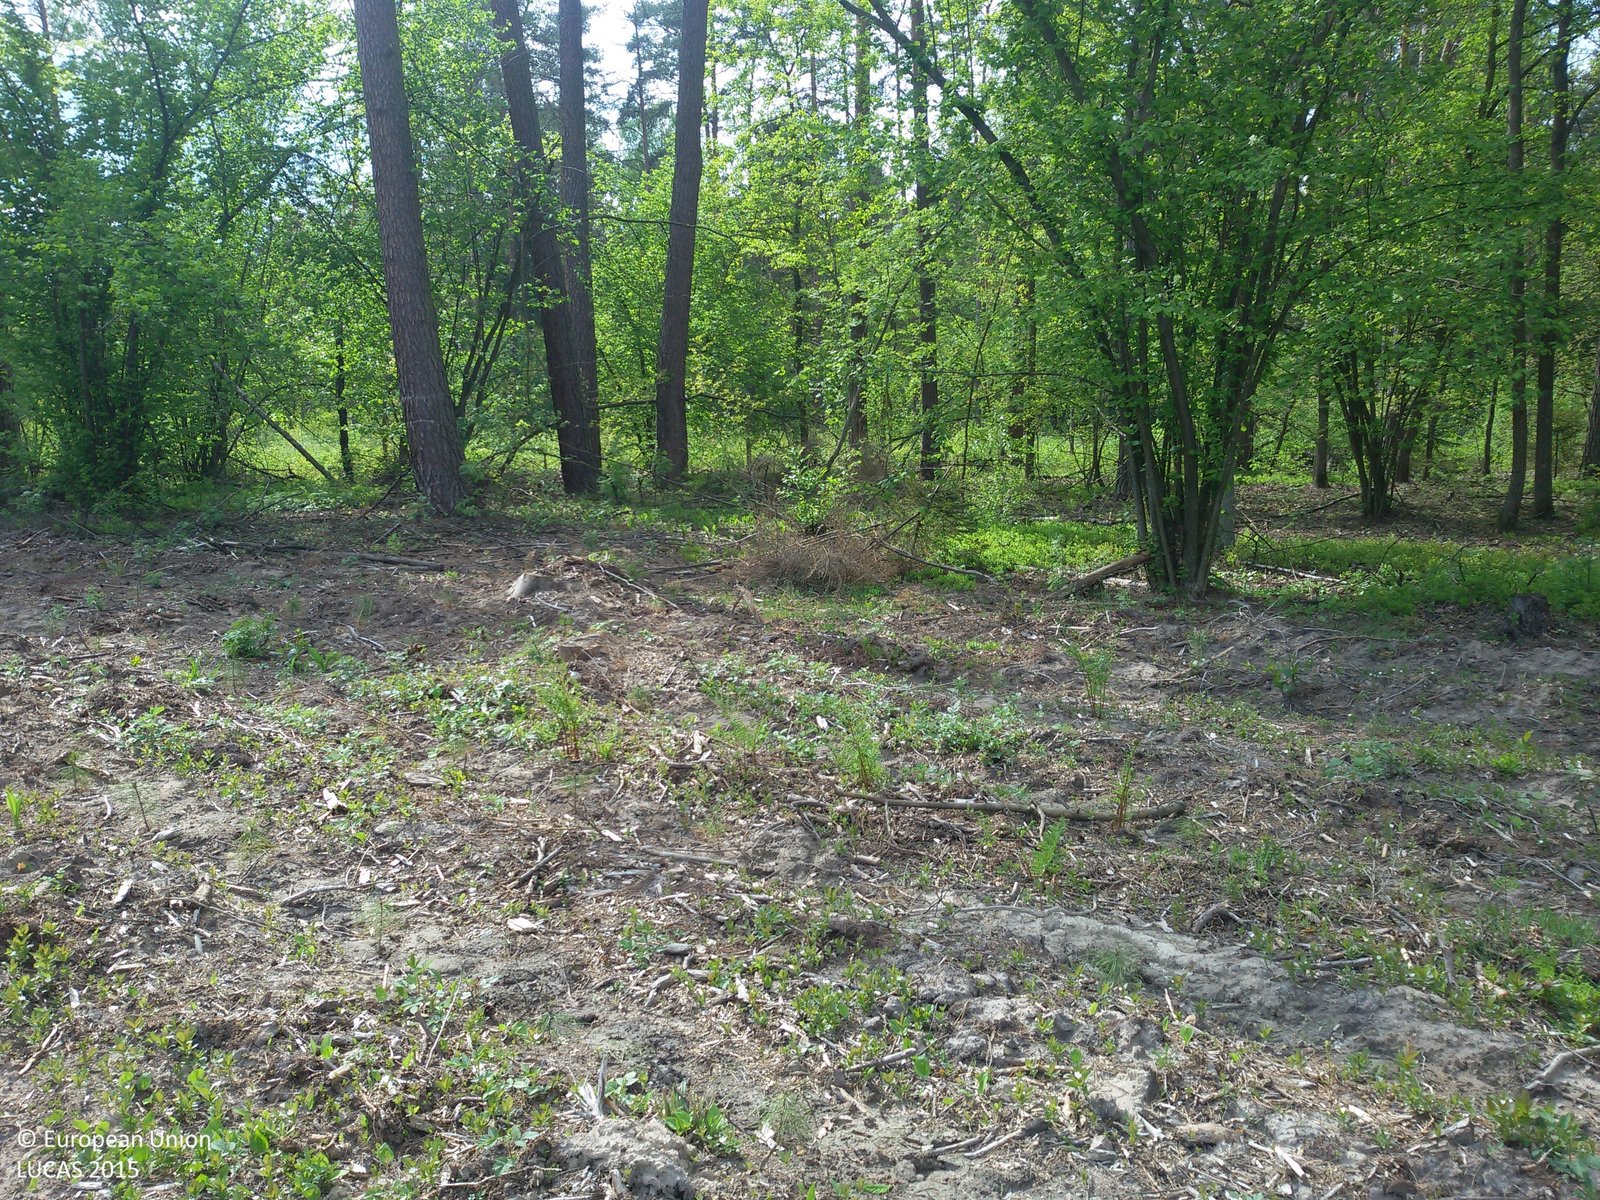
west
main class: Grassland
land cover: Spontaneously vegetated surfaces
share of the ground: 50 - 75 %
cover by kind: herbaceous plants 55 %, unconsolidated bare surface 45 %
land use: Forestry
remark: Clear cut
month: May
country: PL
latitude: 51.7874
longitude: 21.0484
